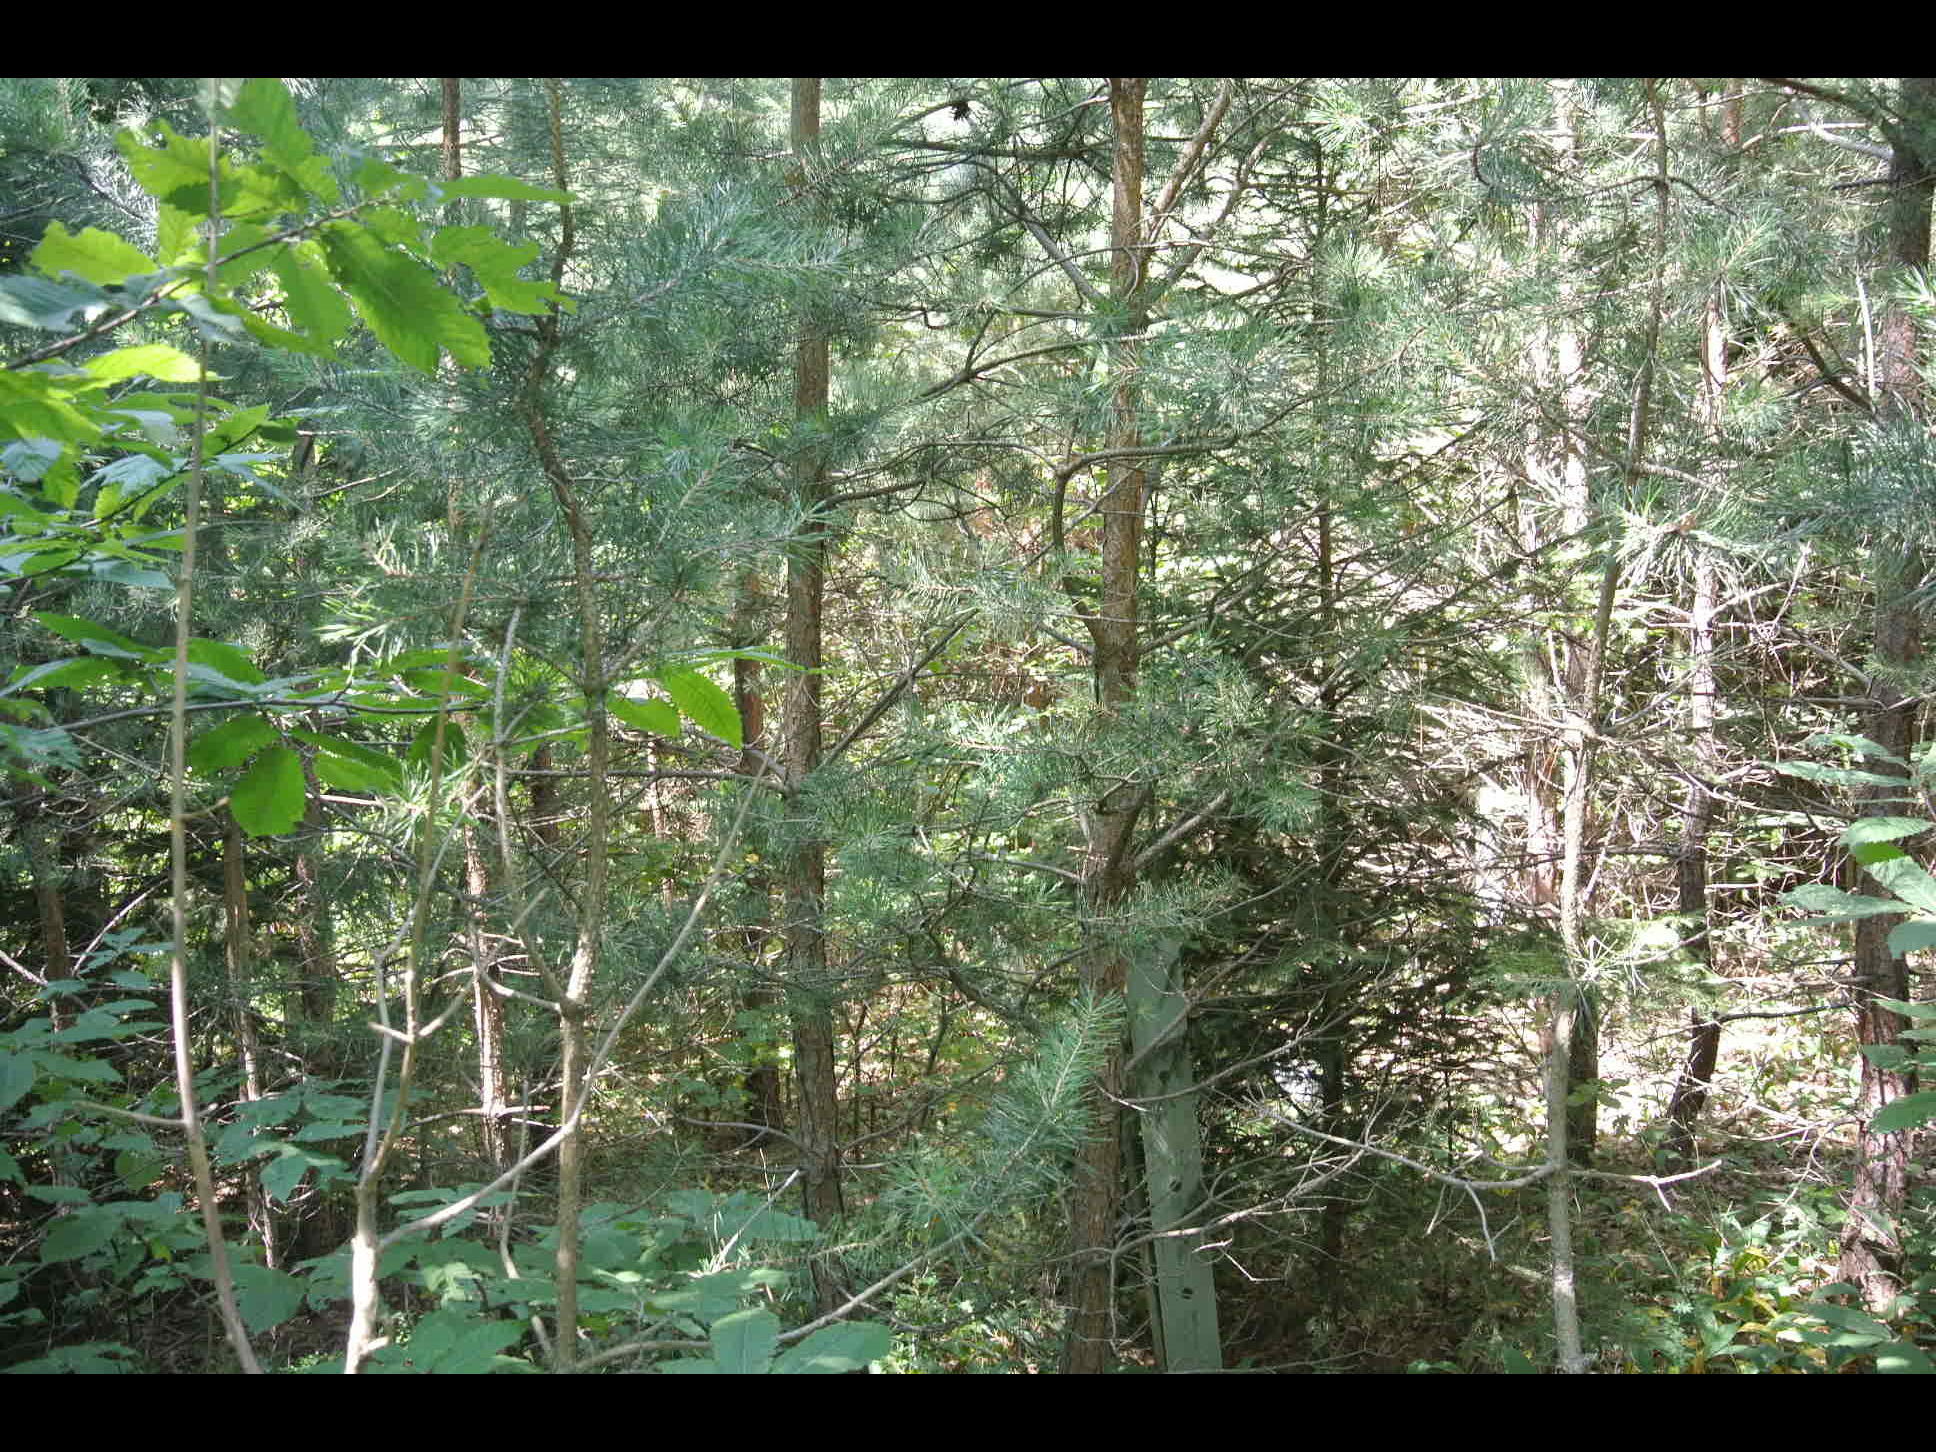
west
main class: Woodland
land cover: Pine dominated mixed woodland
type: alpine coniferous forest
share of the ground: > 75 %
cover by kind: coniferous forest trees 50 %, broadleaved forest trees 45 %, herbaceous plants 5 %
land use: Forestry
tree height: > 5 m
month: July
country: AT
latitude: 47.6938
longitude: 16.4129
